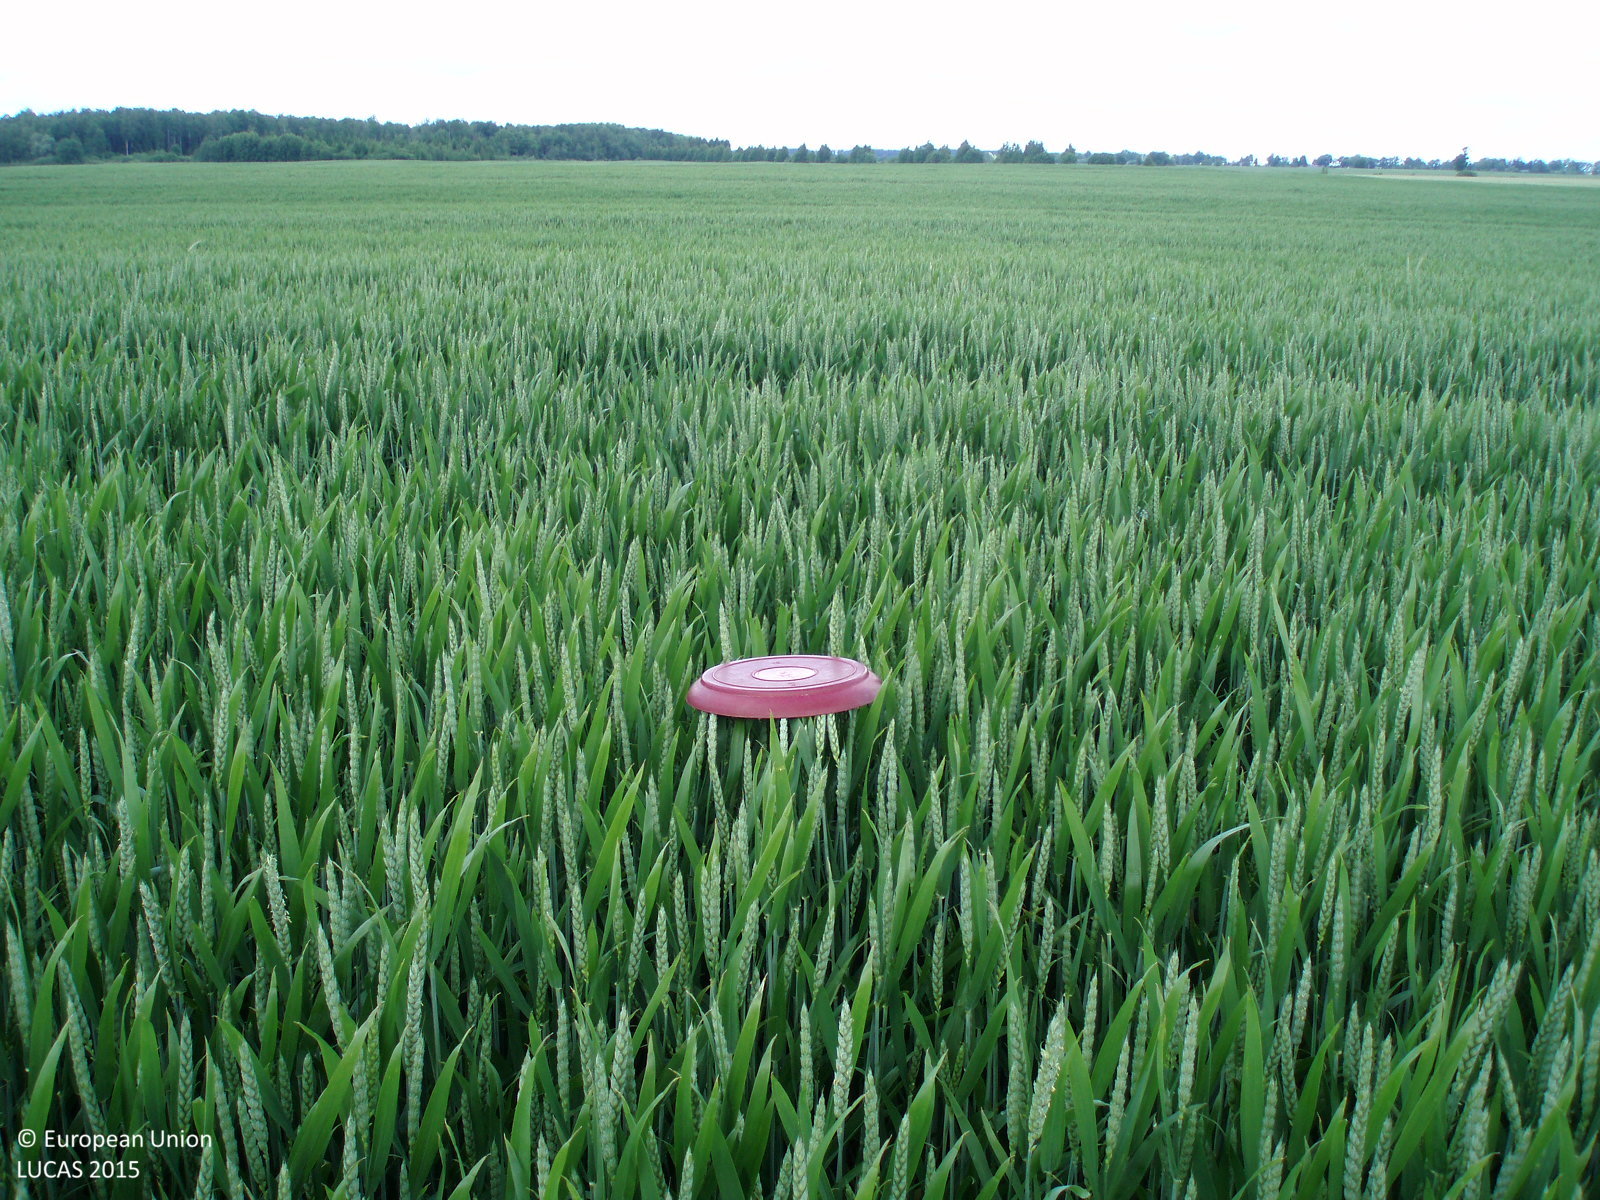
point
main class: Cropland
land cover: Common wheat
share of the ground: > 75 %
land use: Agriculture (excluding fallow land and kitchen gardens)
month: June
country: LT
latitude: 56.2972
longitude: 23.2736
